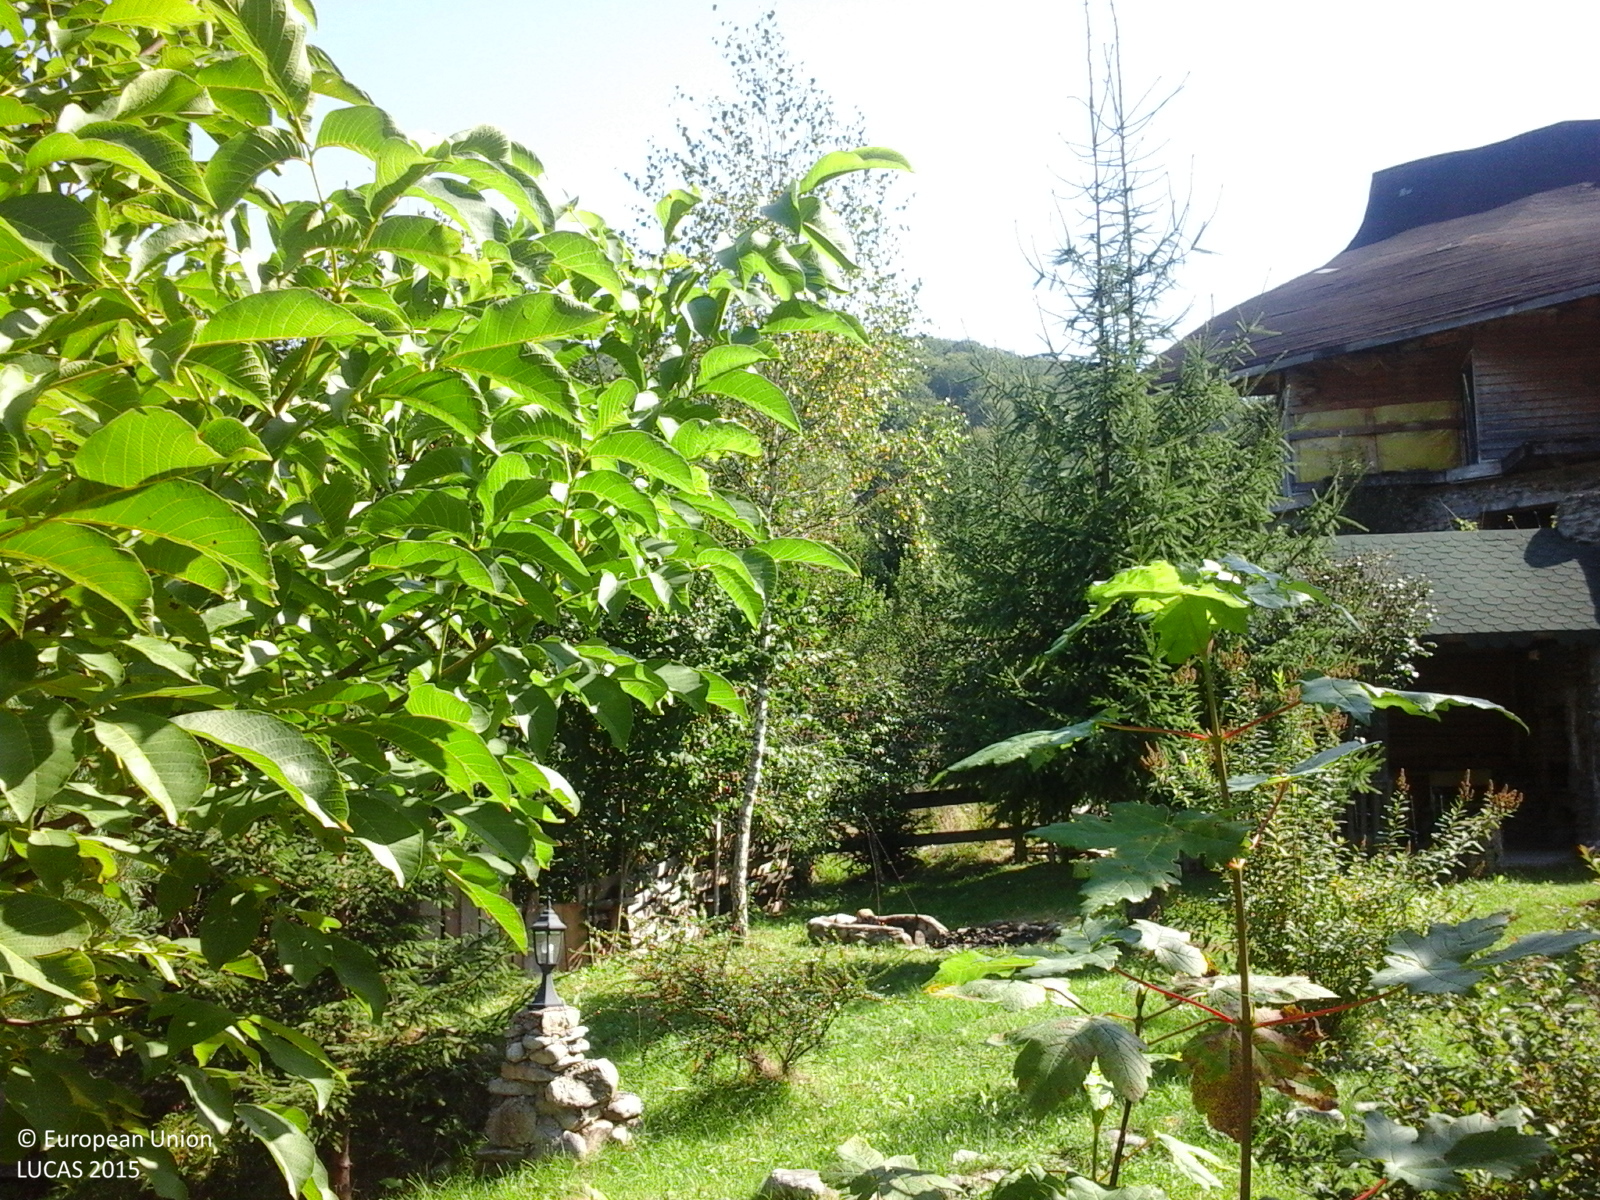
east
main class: Grassland
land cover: Grassland with sparse tree/shrub cover
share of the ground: > 75 %
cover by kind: herbaceous plants 85 %, shrubs 10 %, broadleaved forest trees 5 %
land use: Agriculture (excluding fallow land and kitchen gardens)
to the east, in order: Grassland with sparse tree/shrub cover; Artificial constructions in urban areas; Other mixed woodland; Artificial constructions in urban areas
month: September
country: RO
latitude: 46.7910
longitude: 22.5648
